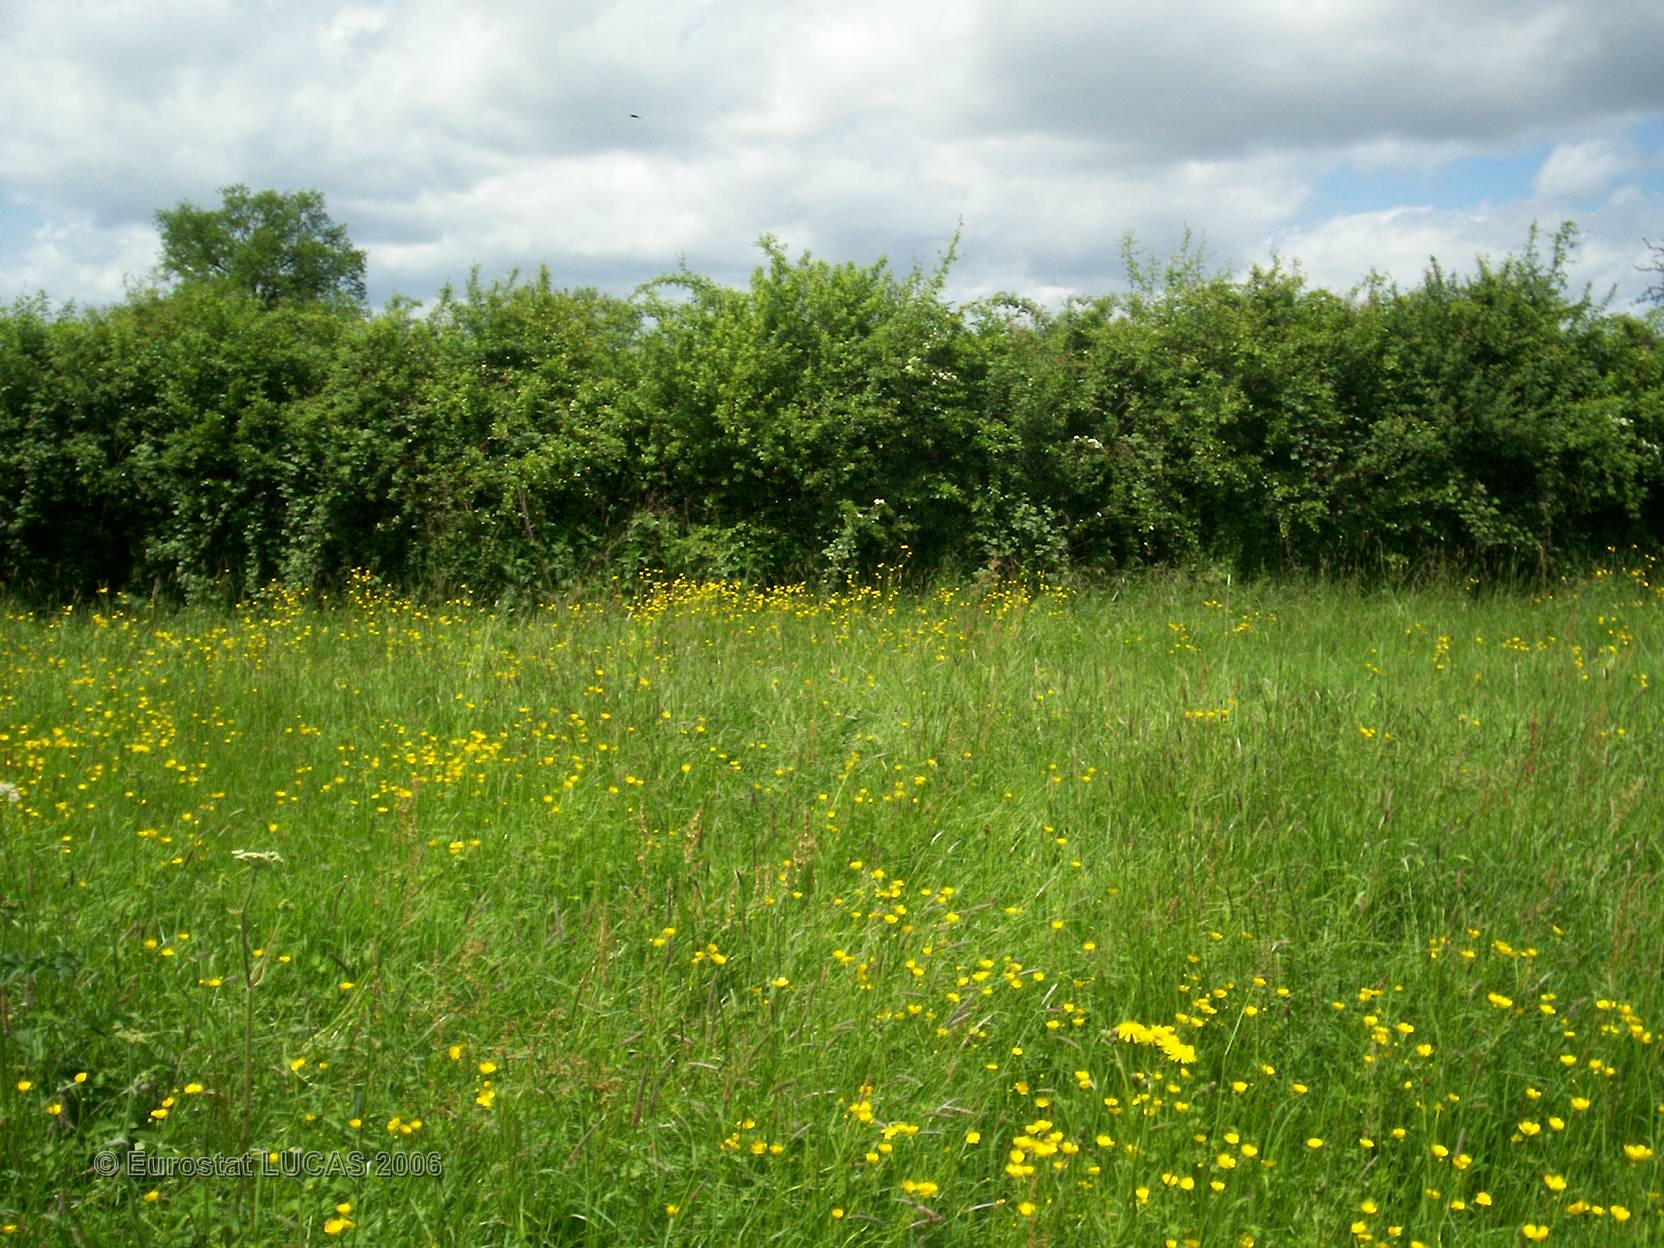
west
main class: Grassland
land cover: Grassland without tree/shrub cover
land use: Agriculture (excluding fallow land and kitchen gardens)
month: May
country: FR
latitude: 47.0804
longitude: 4.5869
